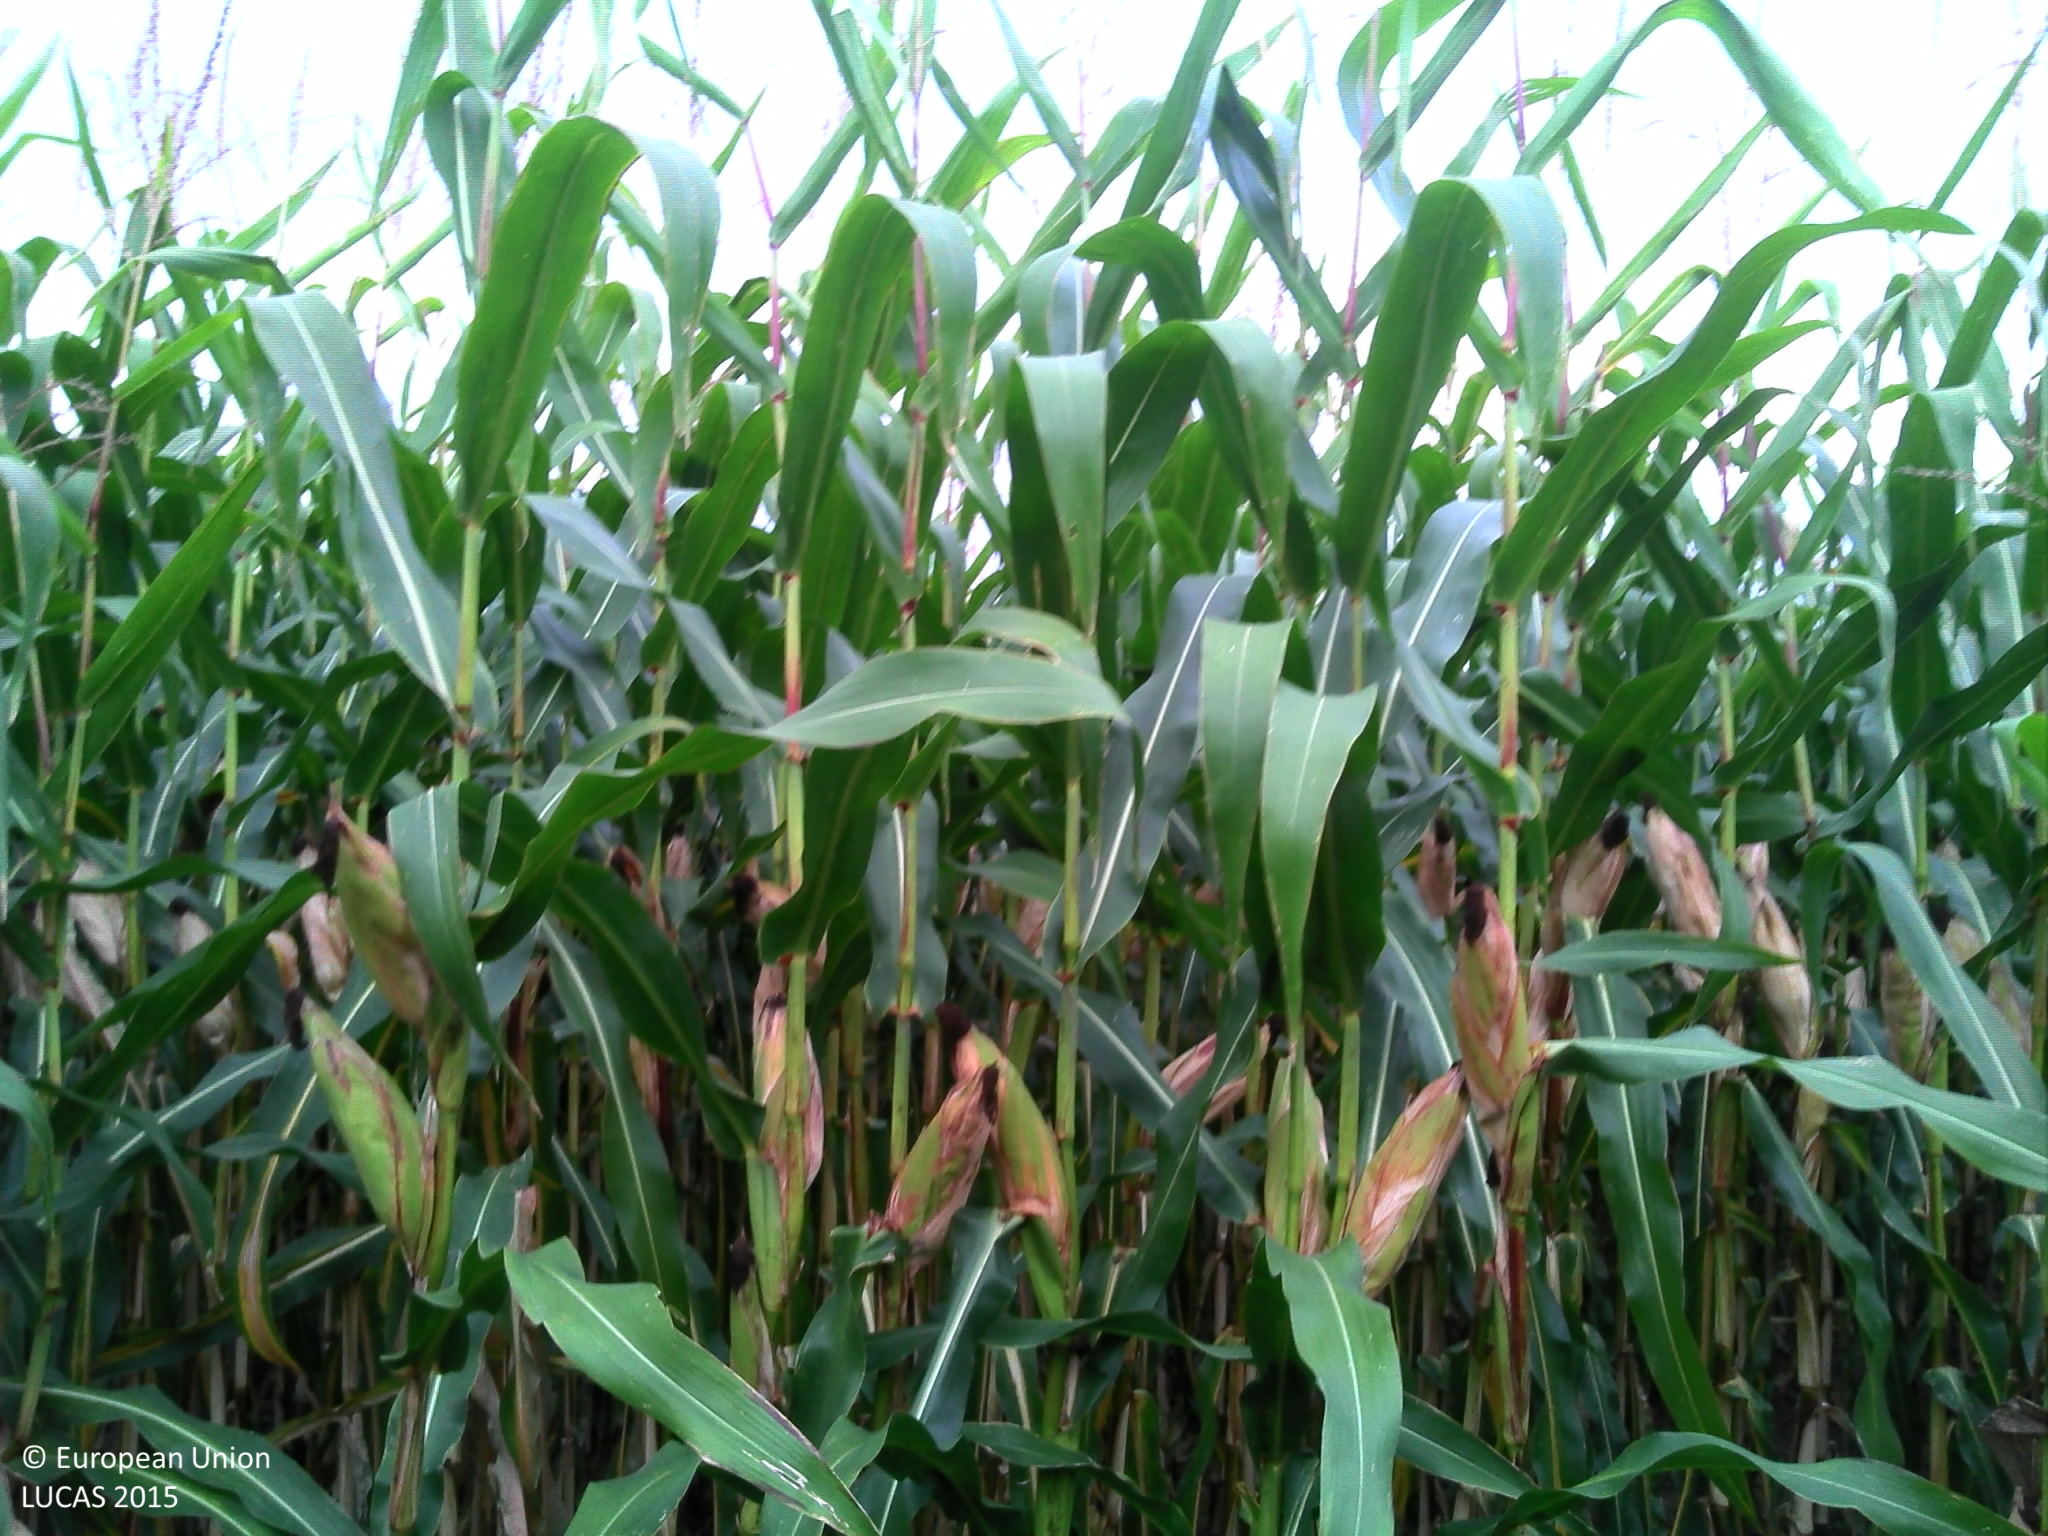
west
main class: Cropland
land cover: Maize
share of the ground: > 75 %
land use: Agriculture (excluding fallow land and kitchen gardens)
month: September
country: FR
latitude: 48.2848
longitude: 7.4808
